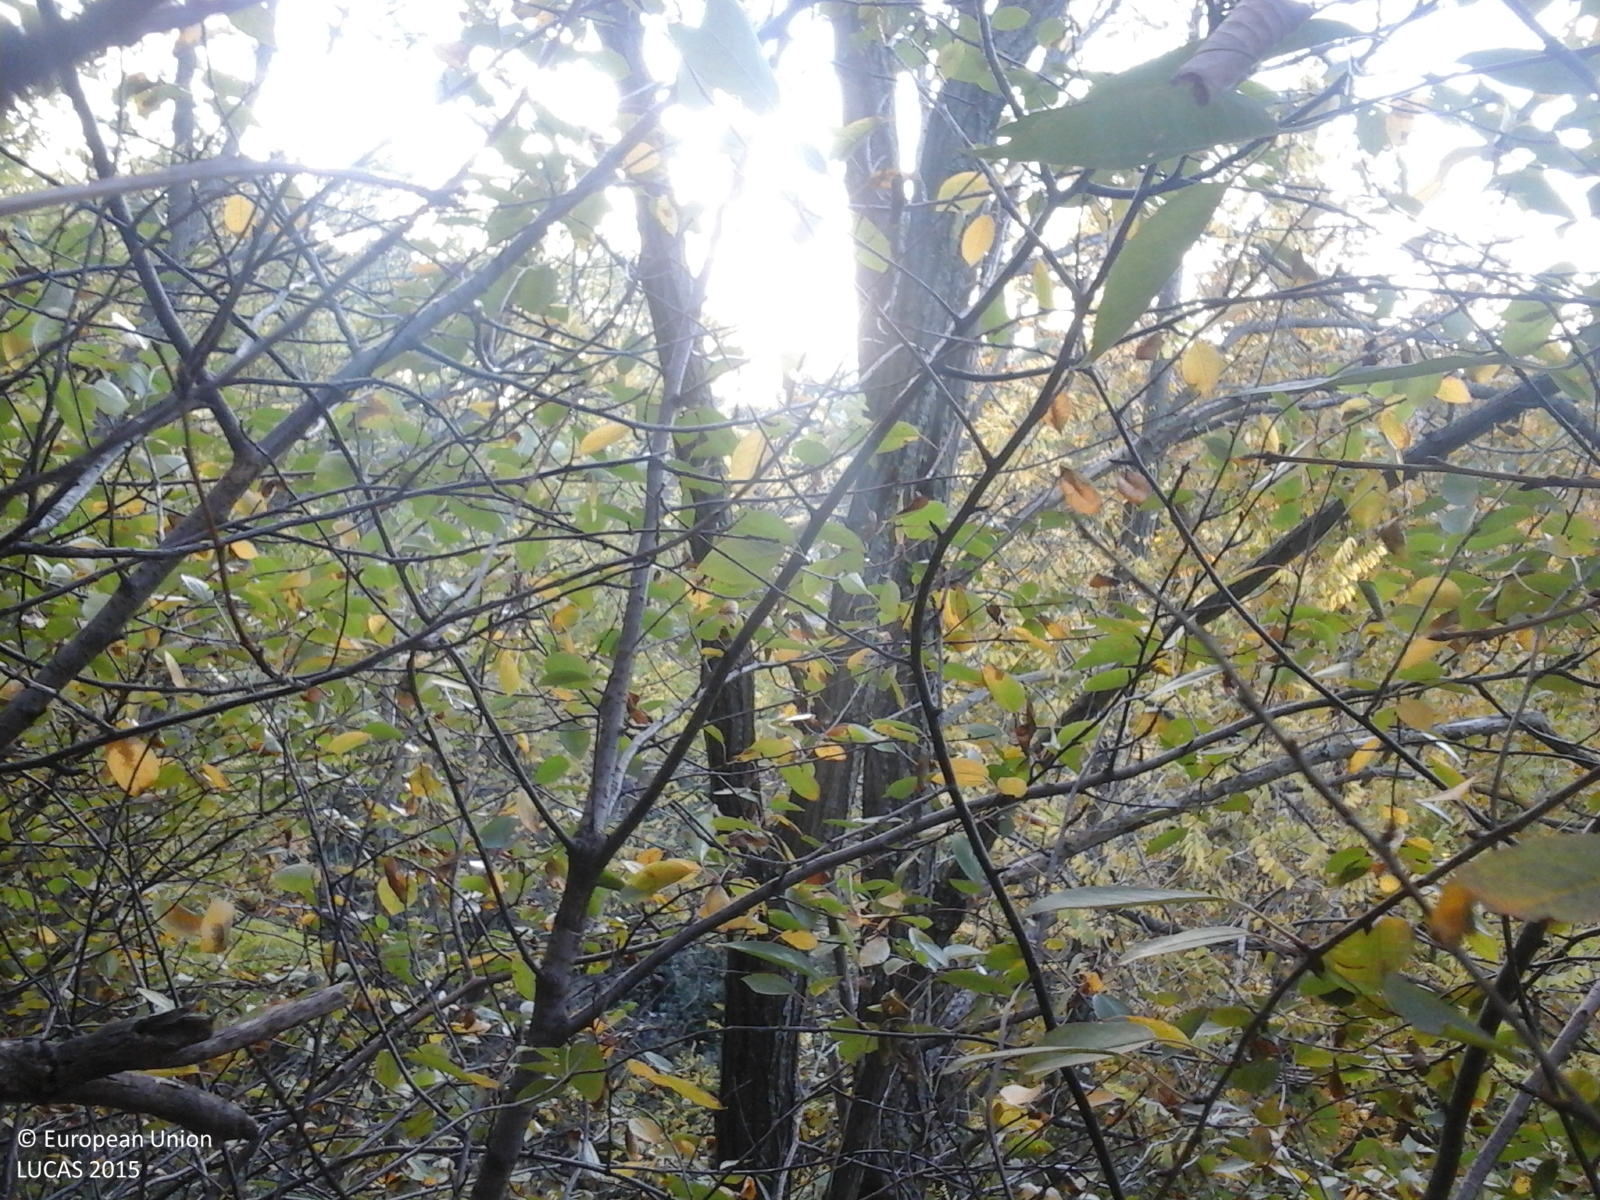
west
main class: Woodland
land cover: Broadleaved woodland
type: exotic forest
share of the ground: > 75 %
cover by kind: broadleaved forest trees 100 %
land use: Forestry
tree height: > 5 m
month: October
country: RO
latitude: 45.4723
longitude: 27.0109
